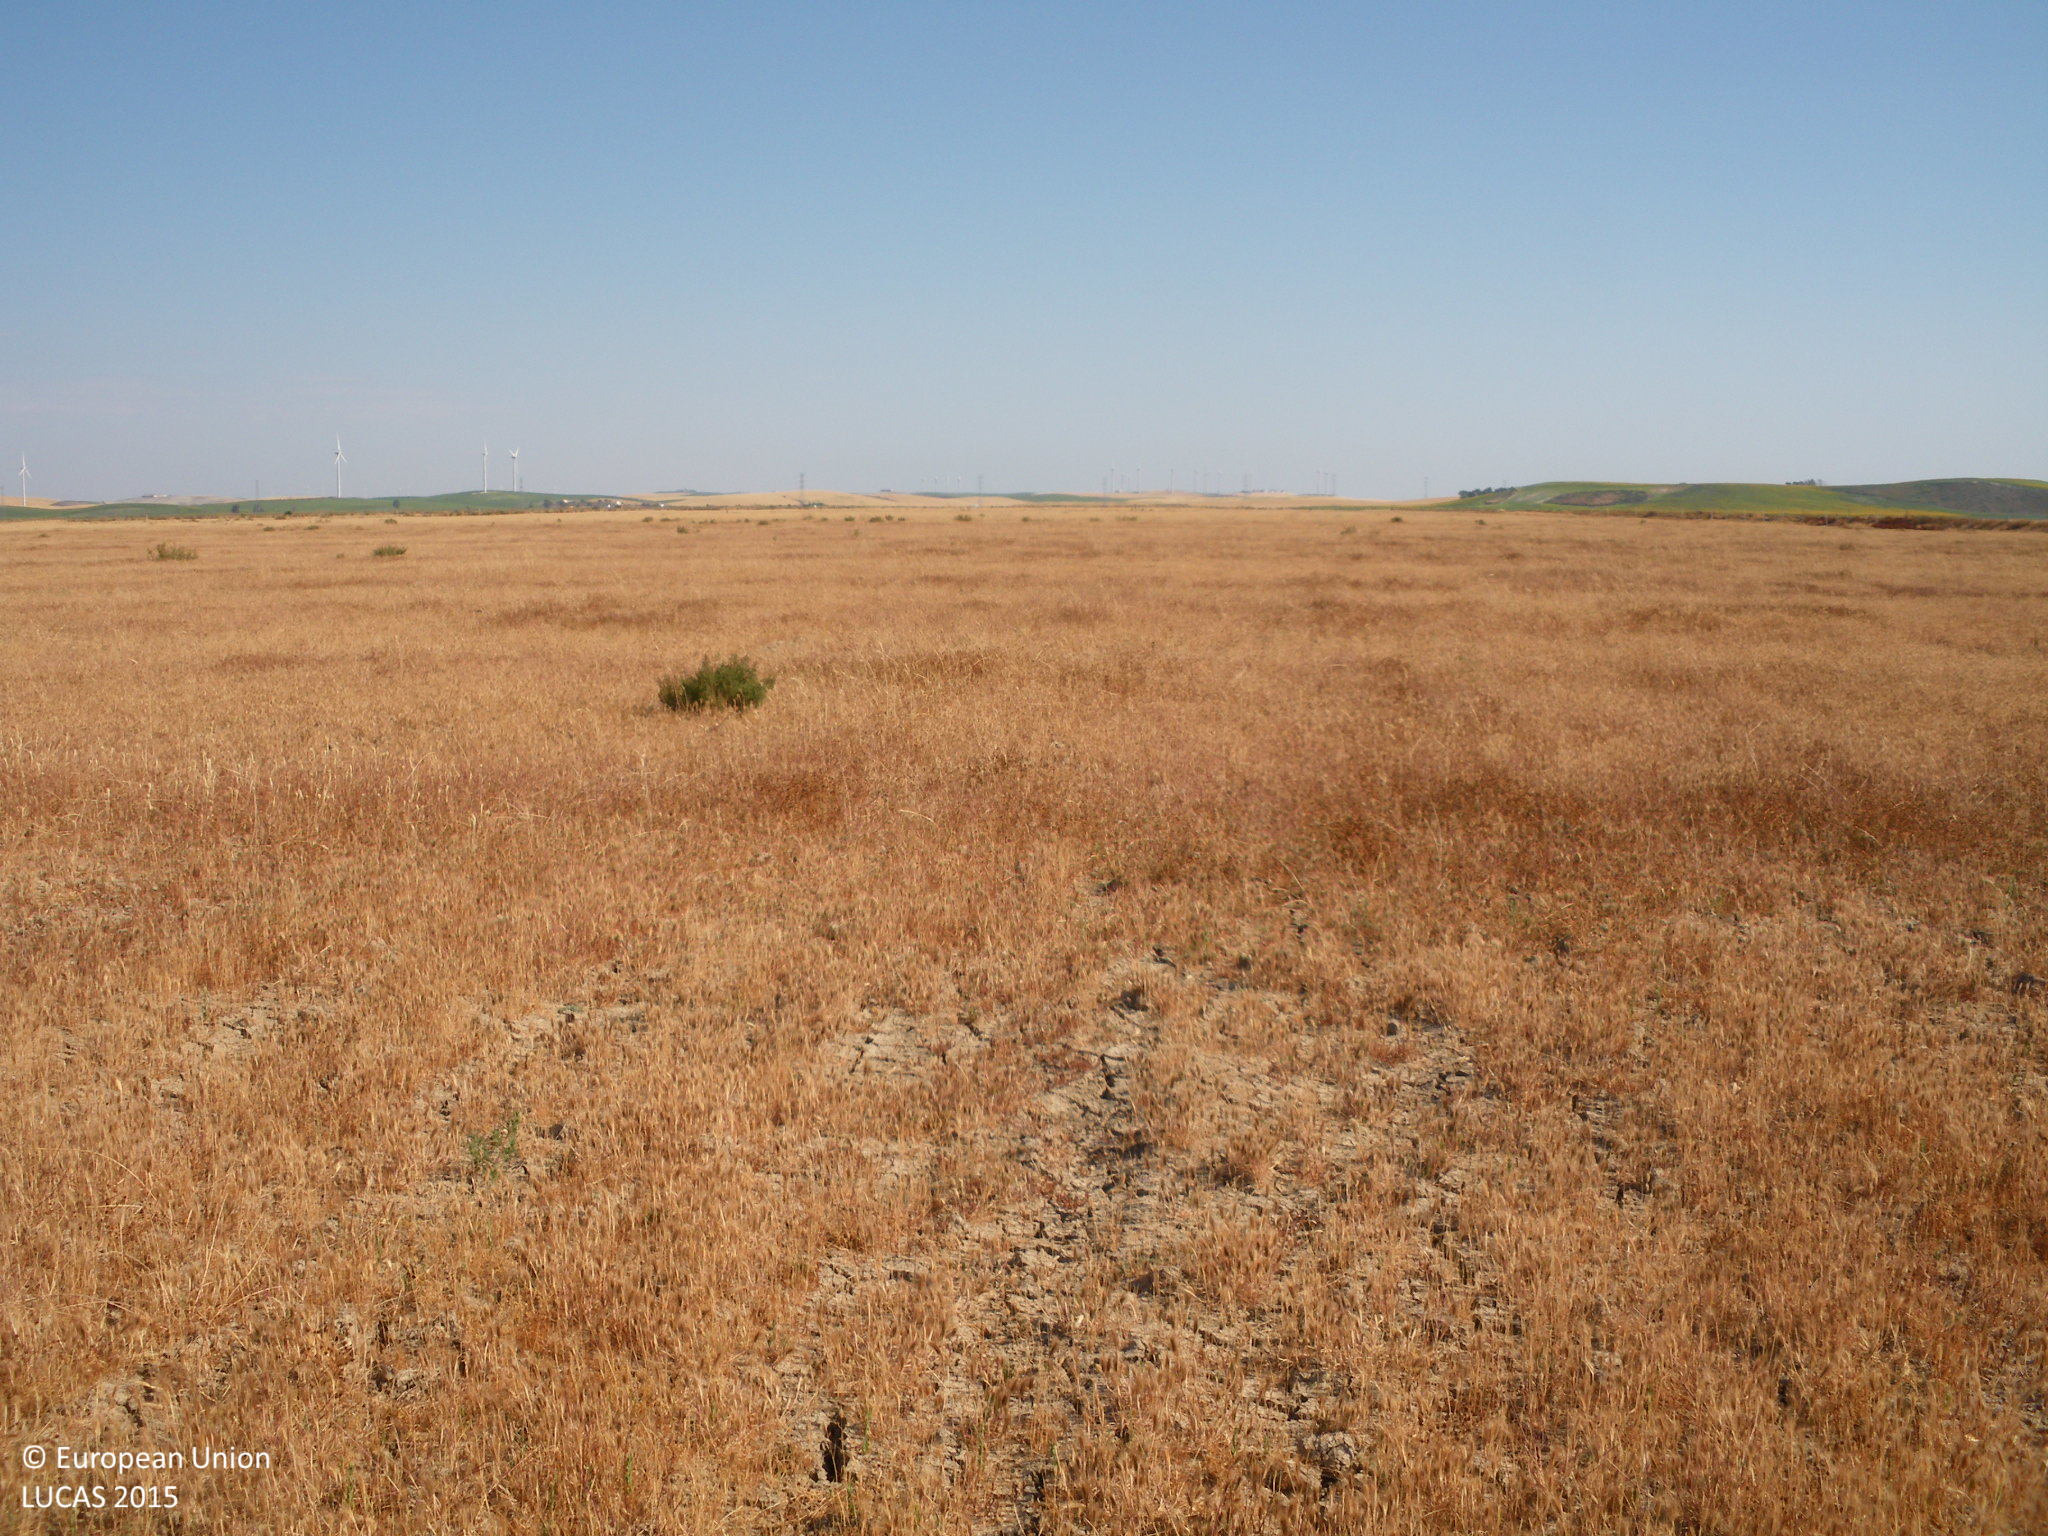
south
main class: Grassland
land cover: Spontaneously vegetated surfaces
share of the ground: > 75 %
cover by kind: herbaceous plants 100 %
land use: Agriculture (excluding fallow land and kitchen gardens)
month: May
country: ES
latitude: 36.8138
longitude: -6.2825
